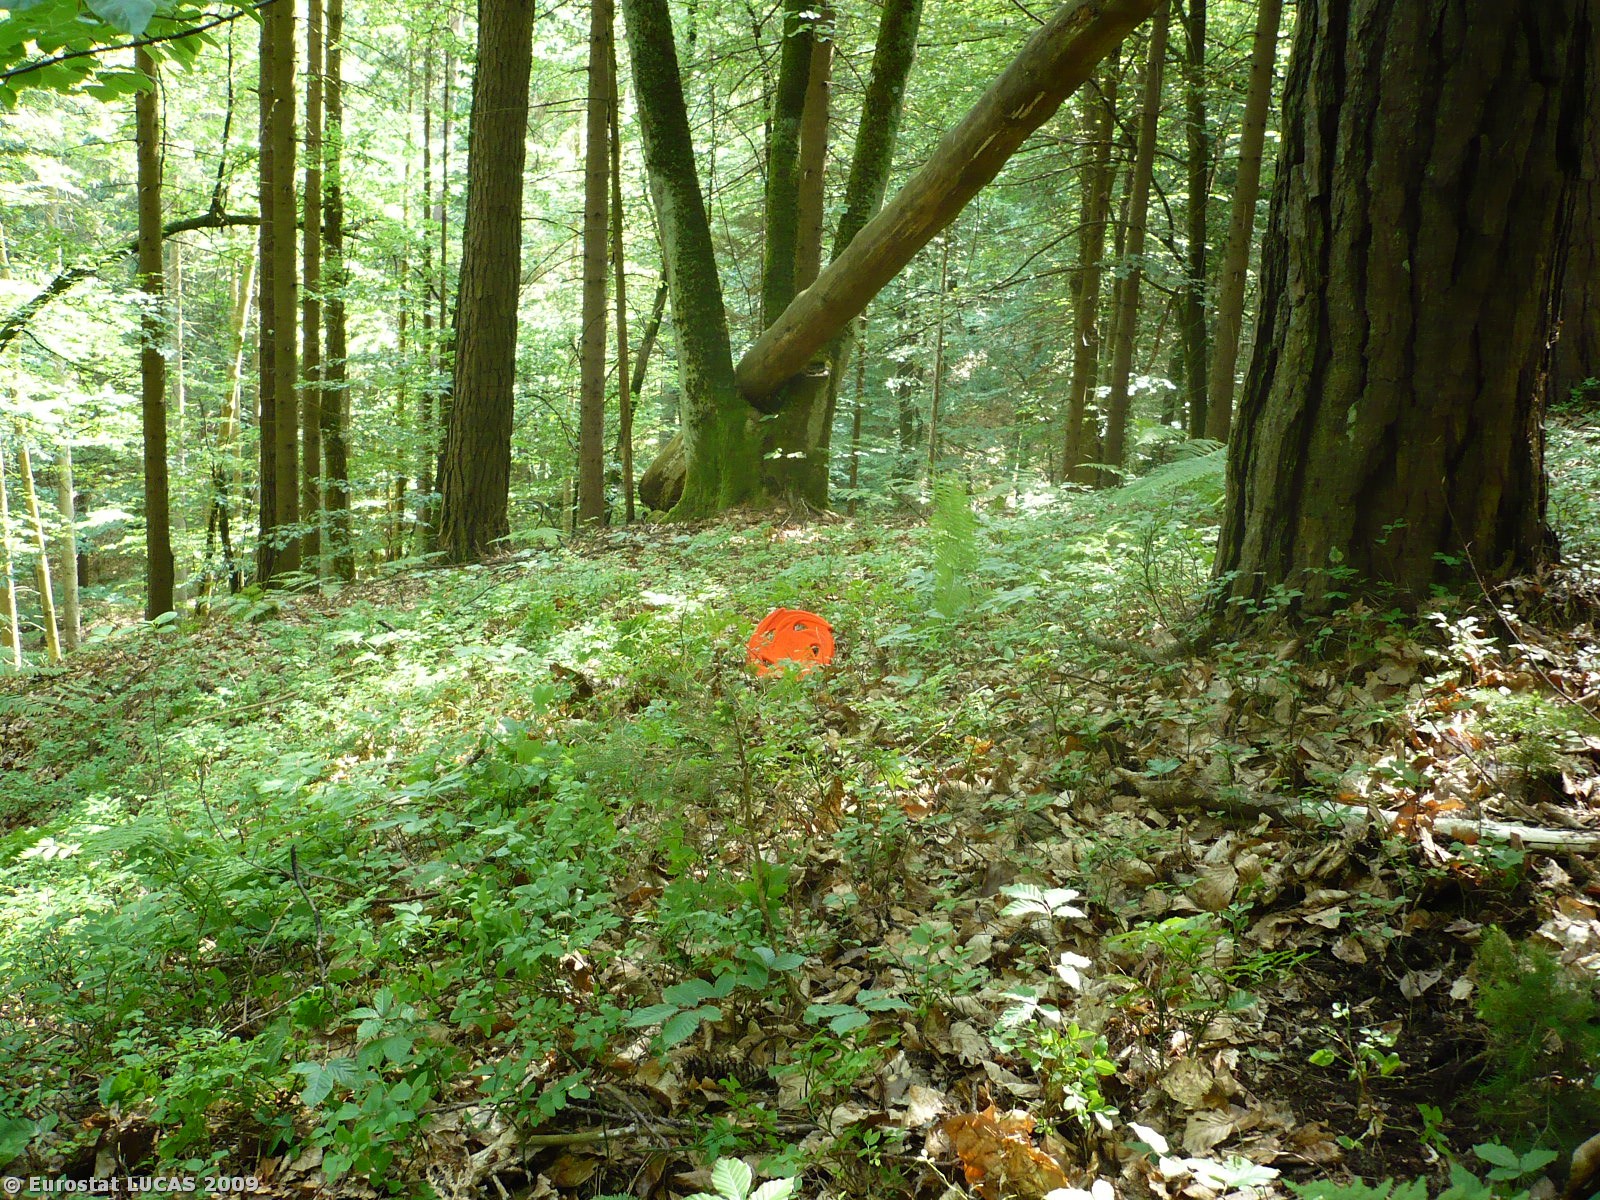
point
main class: Woodland
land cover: Broadleaved woodland
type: beech forest
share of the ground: > 75 %
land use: Forestry
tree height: > 5 m
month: May
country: SI
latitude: 45.8426
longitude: 15.2630
